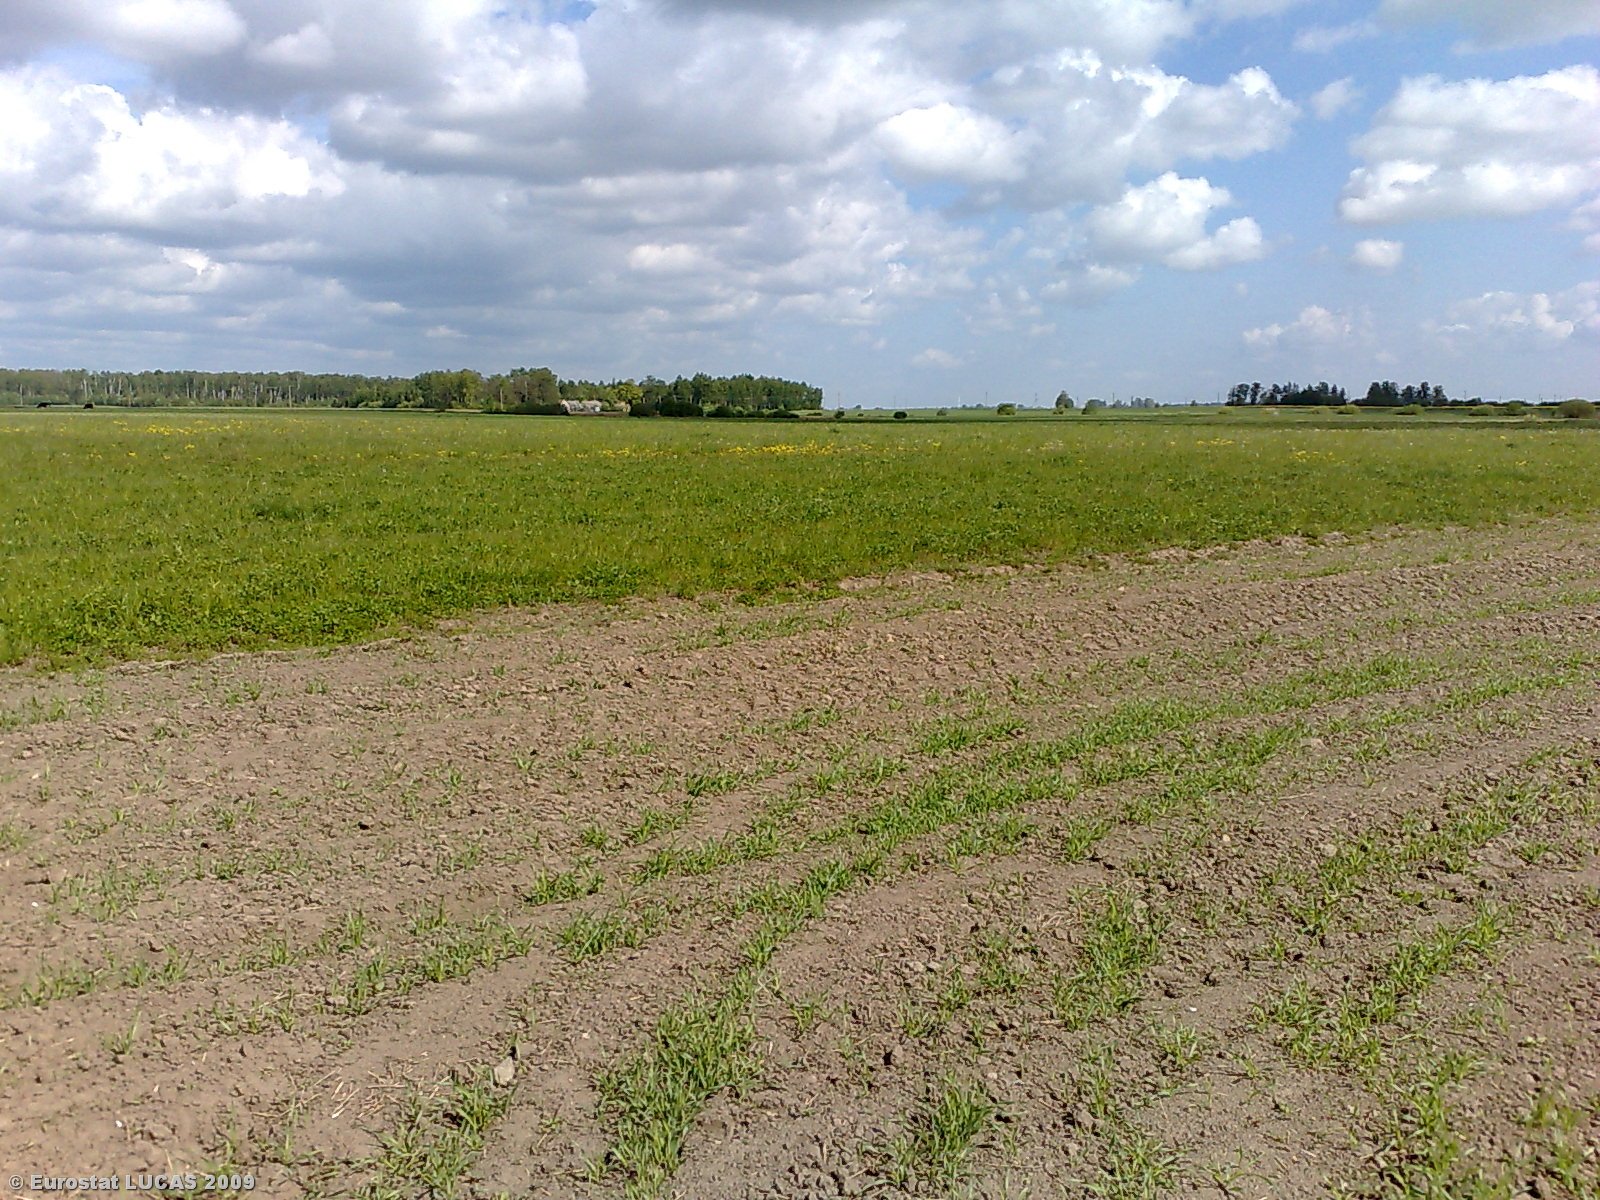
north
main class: Cropland
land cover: Barley
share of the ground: 25 - 50 %
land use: Agriculture (excluding fallow land and kitchen gardens)
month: May
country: LT
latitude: 55.6953
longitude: 23.9446
